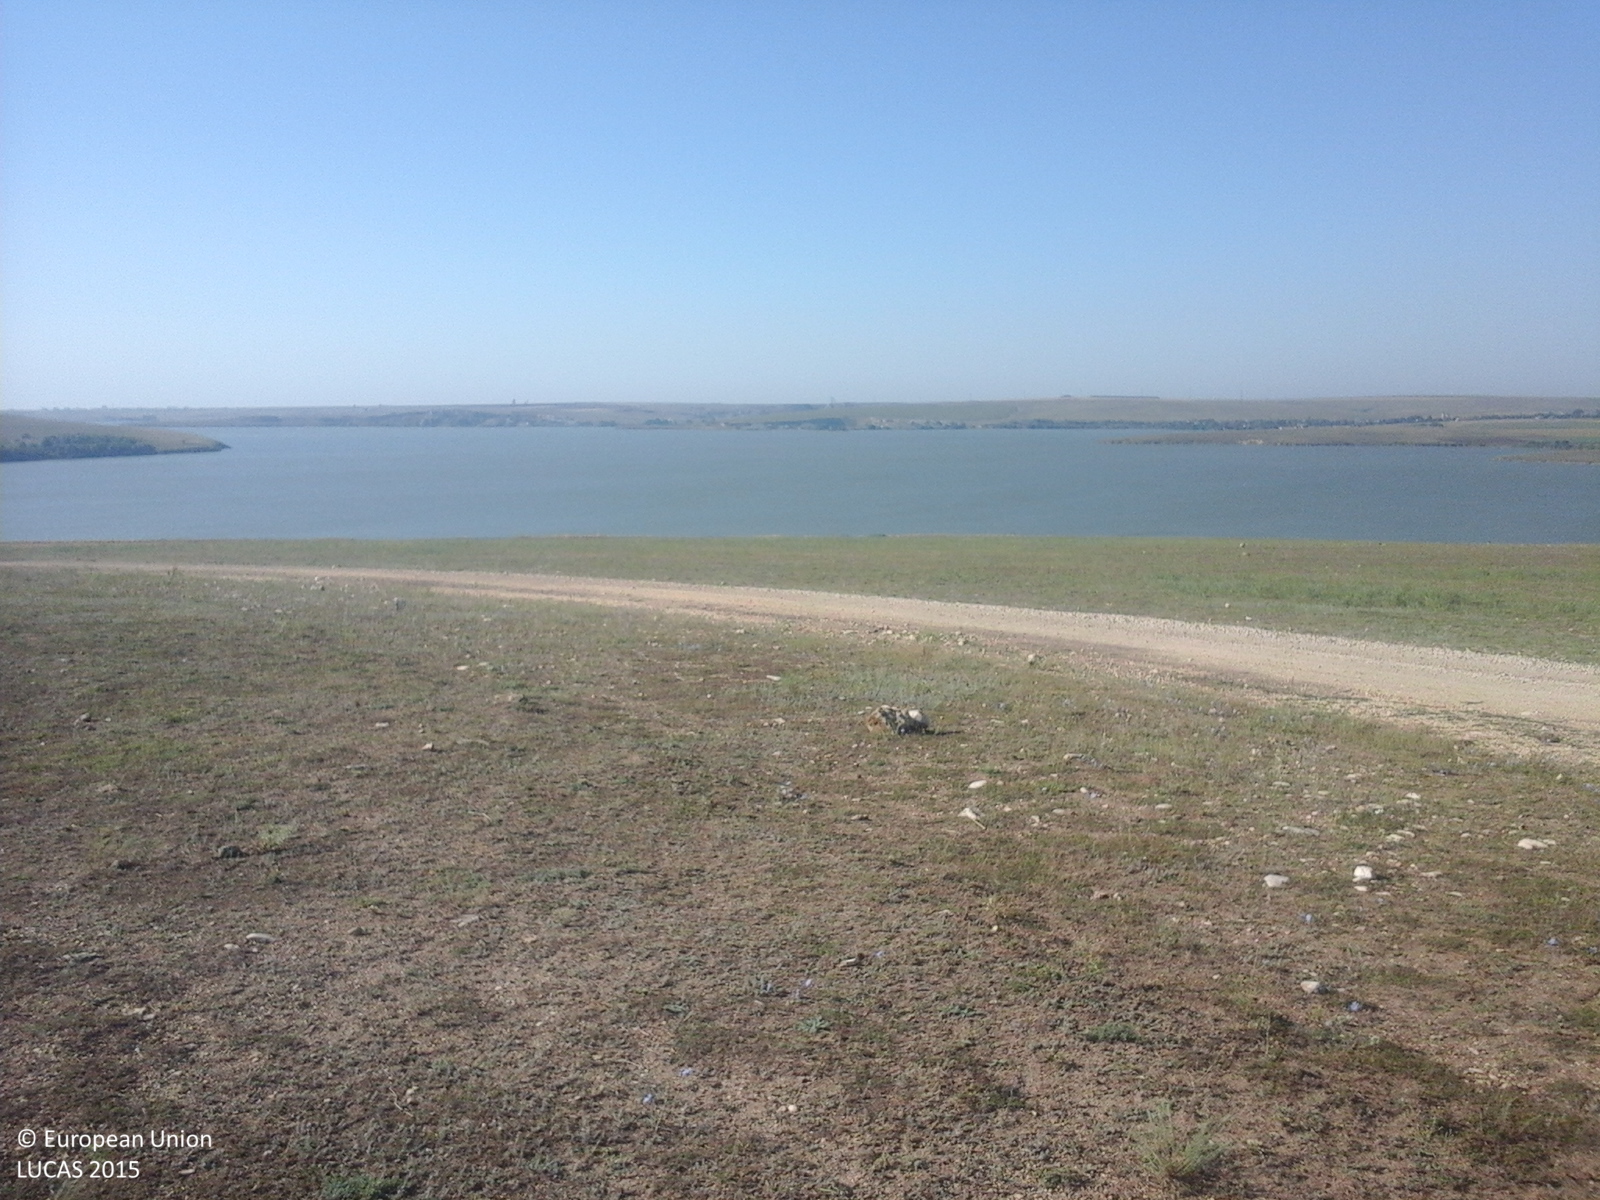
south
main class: Grassland
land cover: Grassland without tree/shrub cover
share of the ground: > 75 %
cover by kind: herbaceous plants 100 %
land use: Agriculture (excluding fallow land and kitchen gardens)
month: August
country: RO
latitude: 44.3930
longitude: 28.5663
